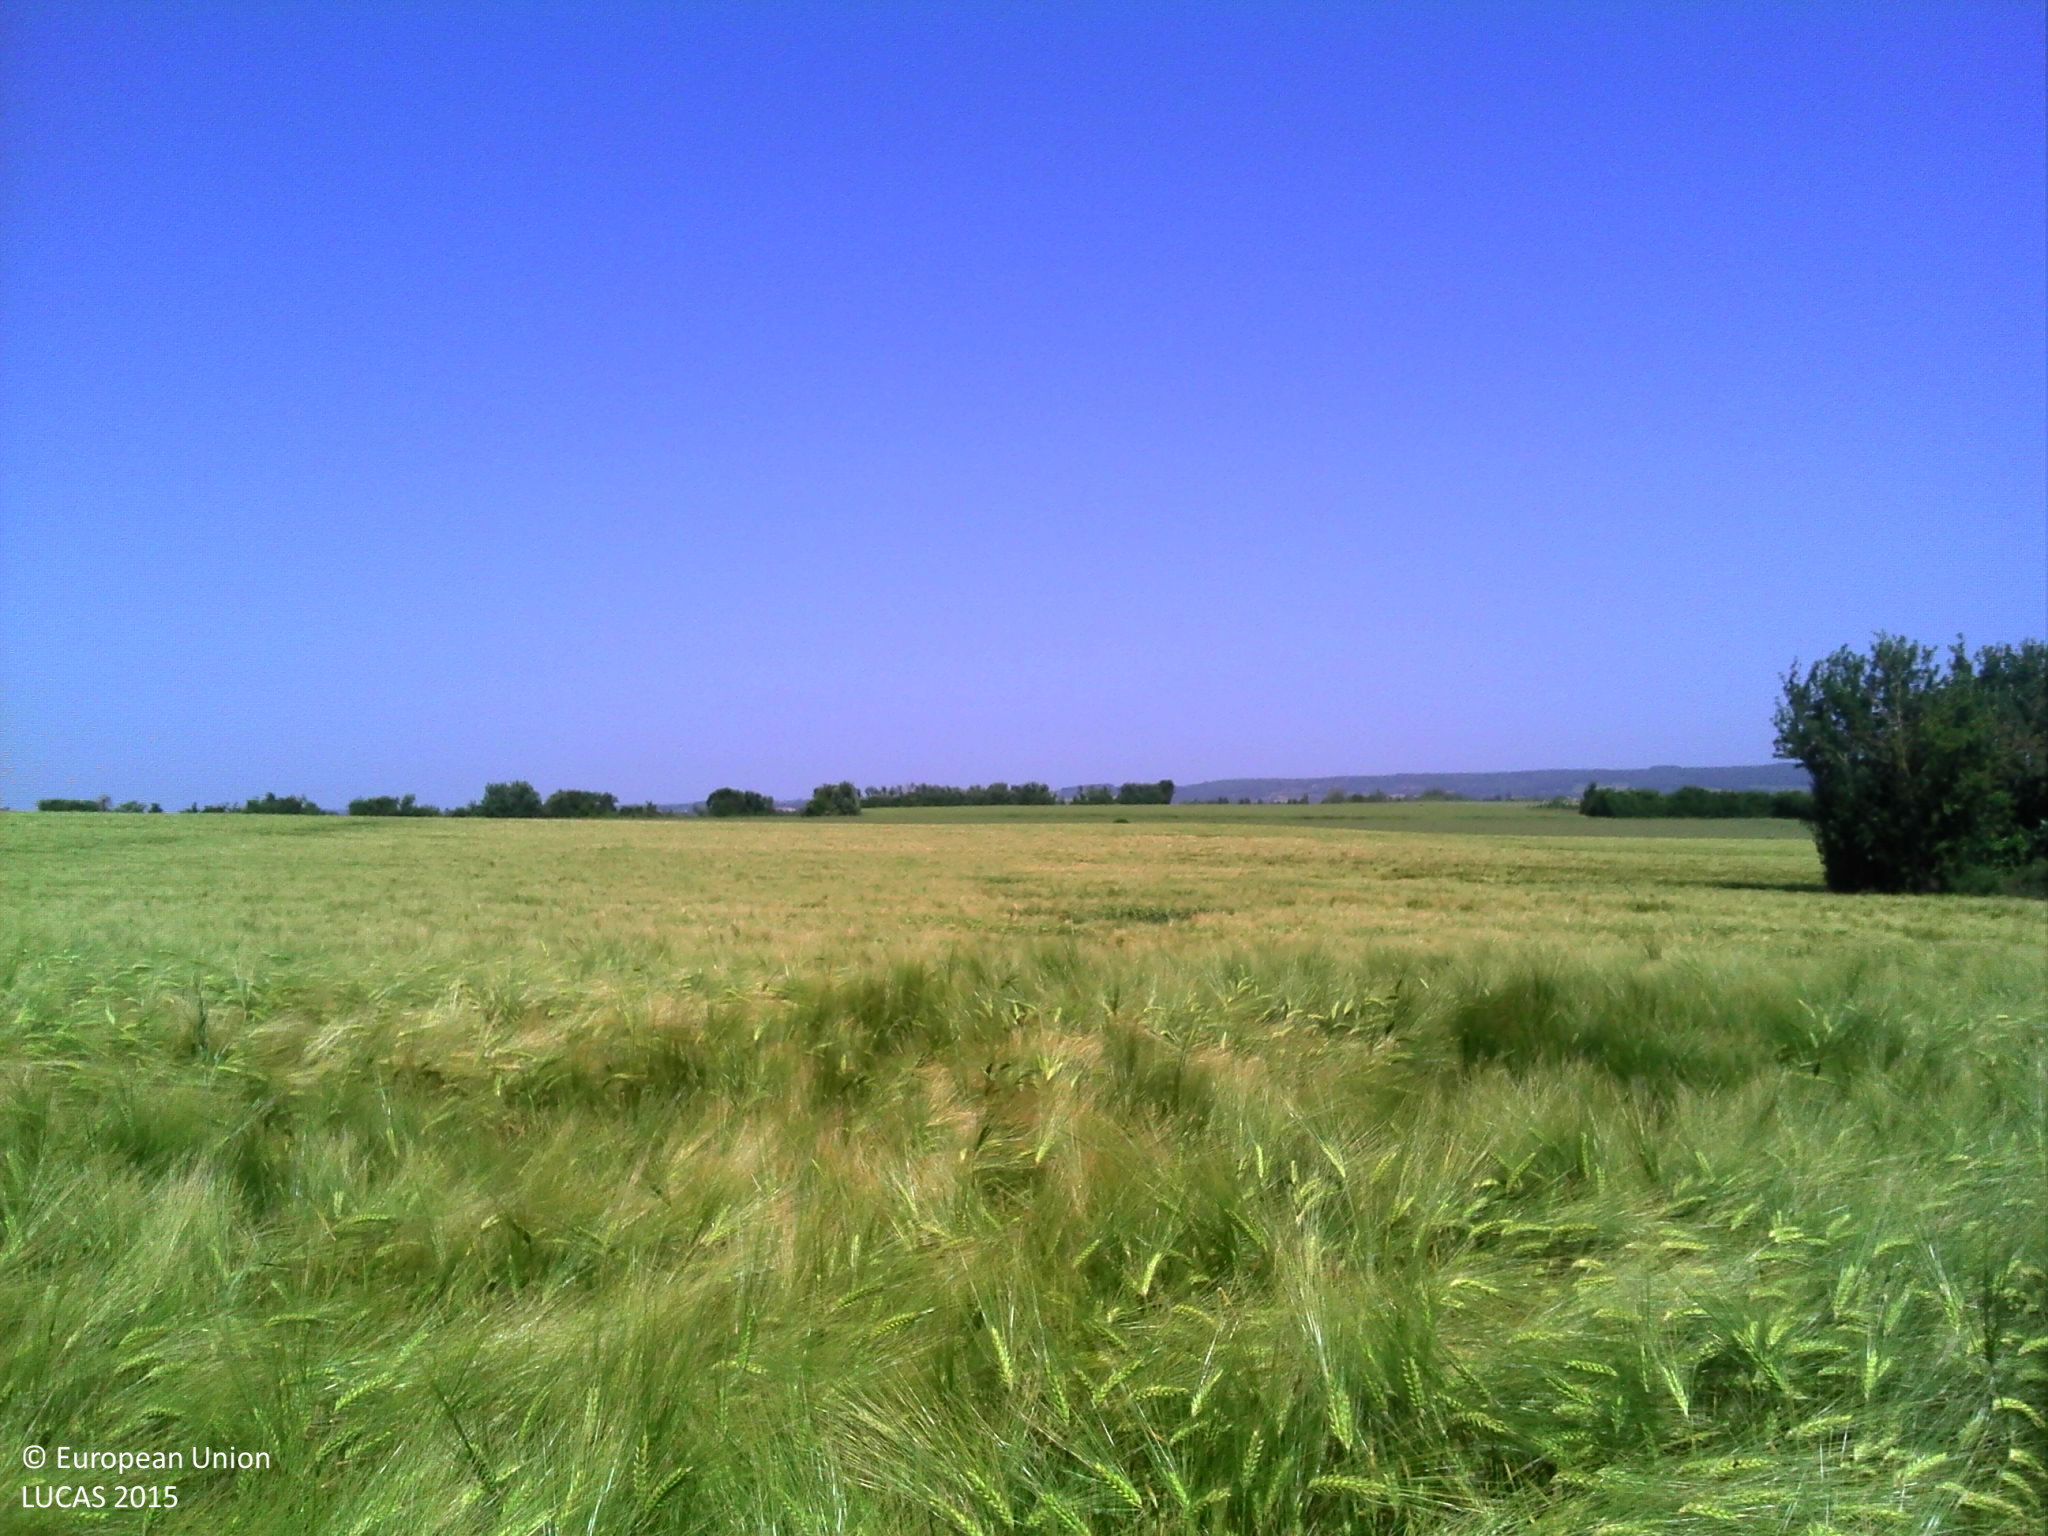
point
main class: Cropland
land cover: Barley
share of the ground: > 75 %
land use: Agriculture (excluding fallow land and kitchen gardens)
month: June
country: FR
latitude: 48.1471
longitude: -0.0151
